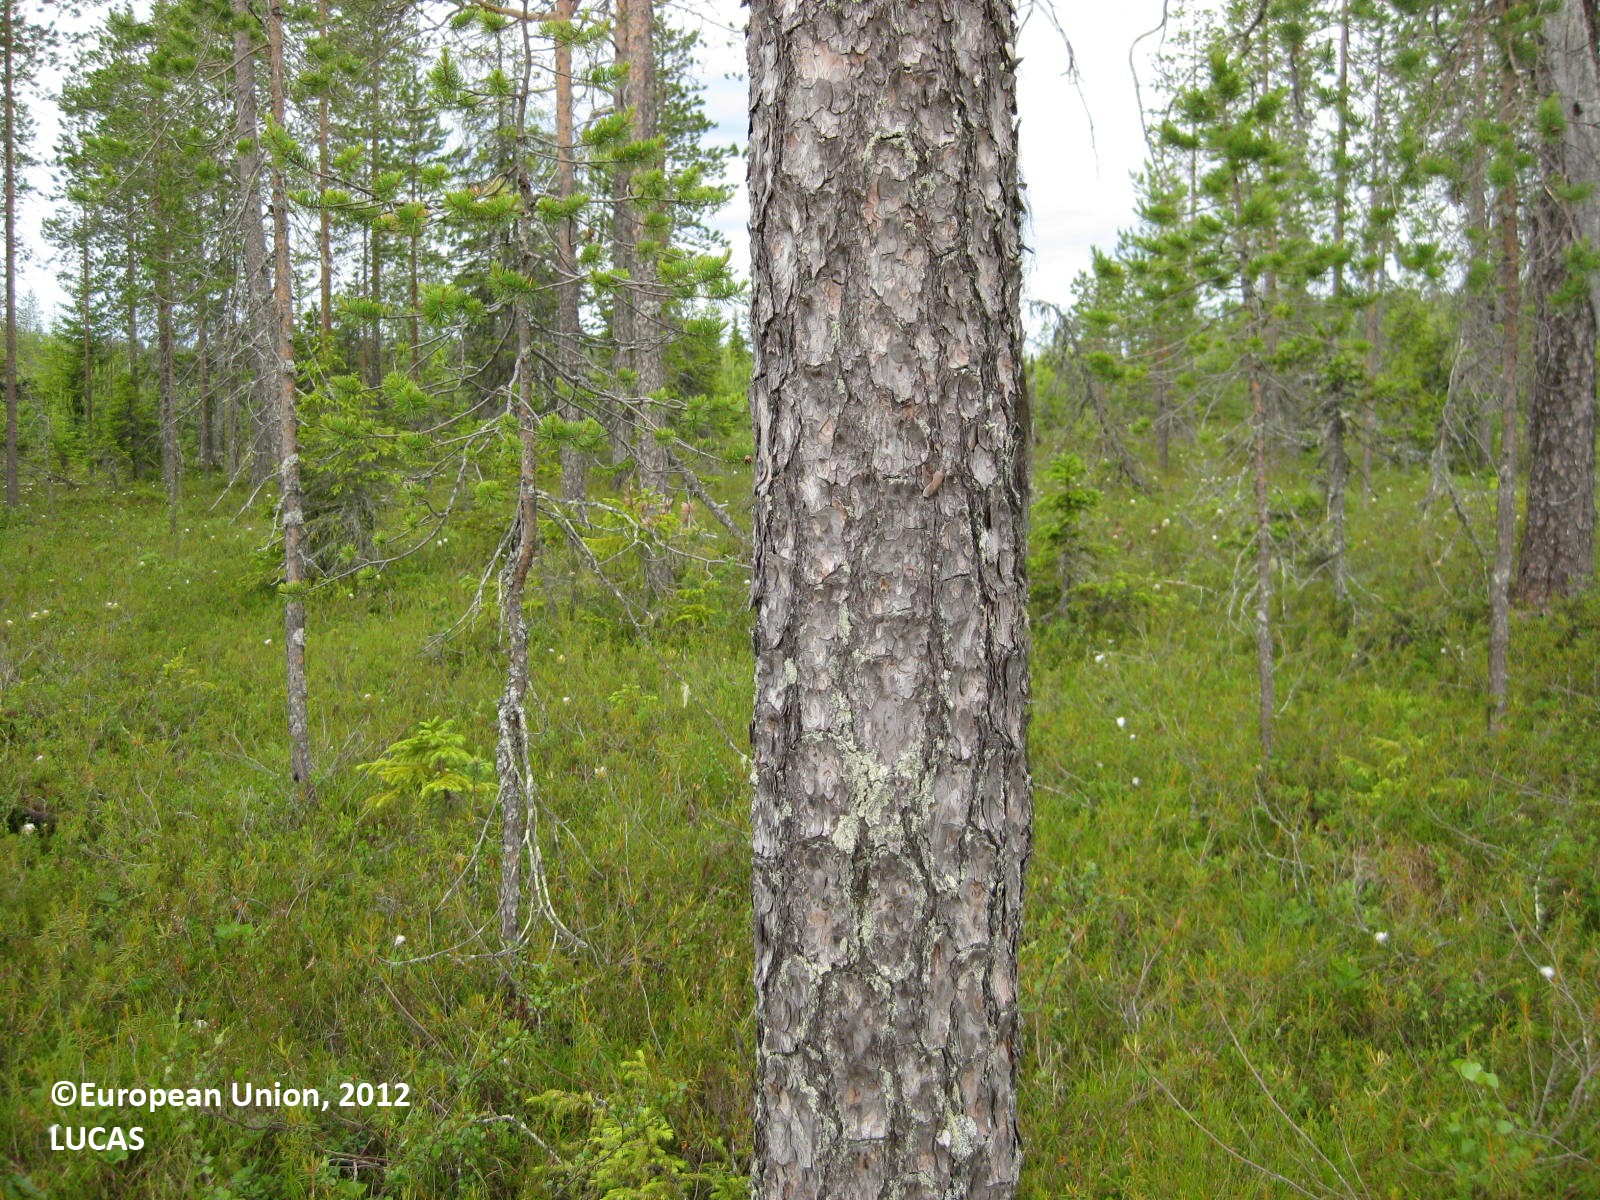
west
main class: Woodland
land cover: Pine dominated coniferous woodland
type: mire and swamp forests
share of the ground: 25 - 50 %
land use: Semi-natural and natural areas not in use
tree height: > 5 m
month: July
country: FI
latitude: 65.5471
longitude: 29.2173
